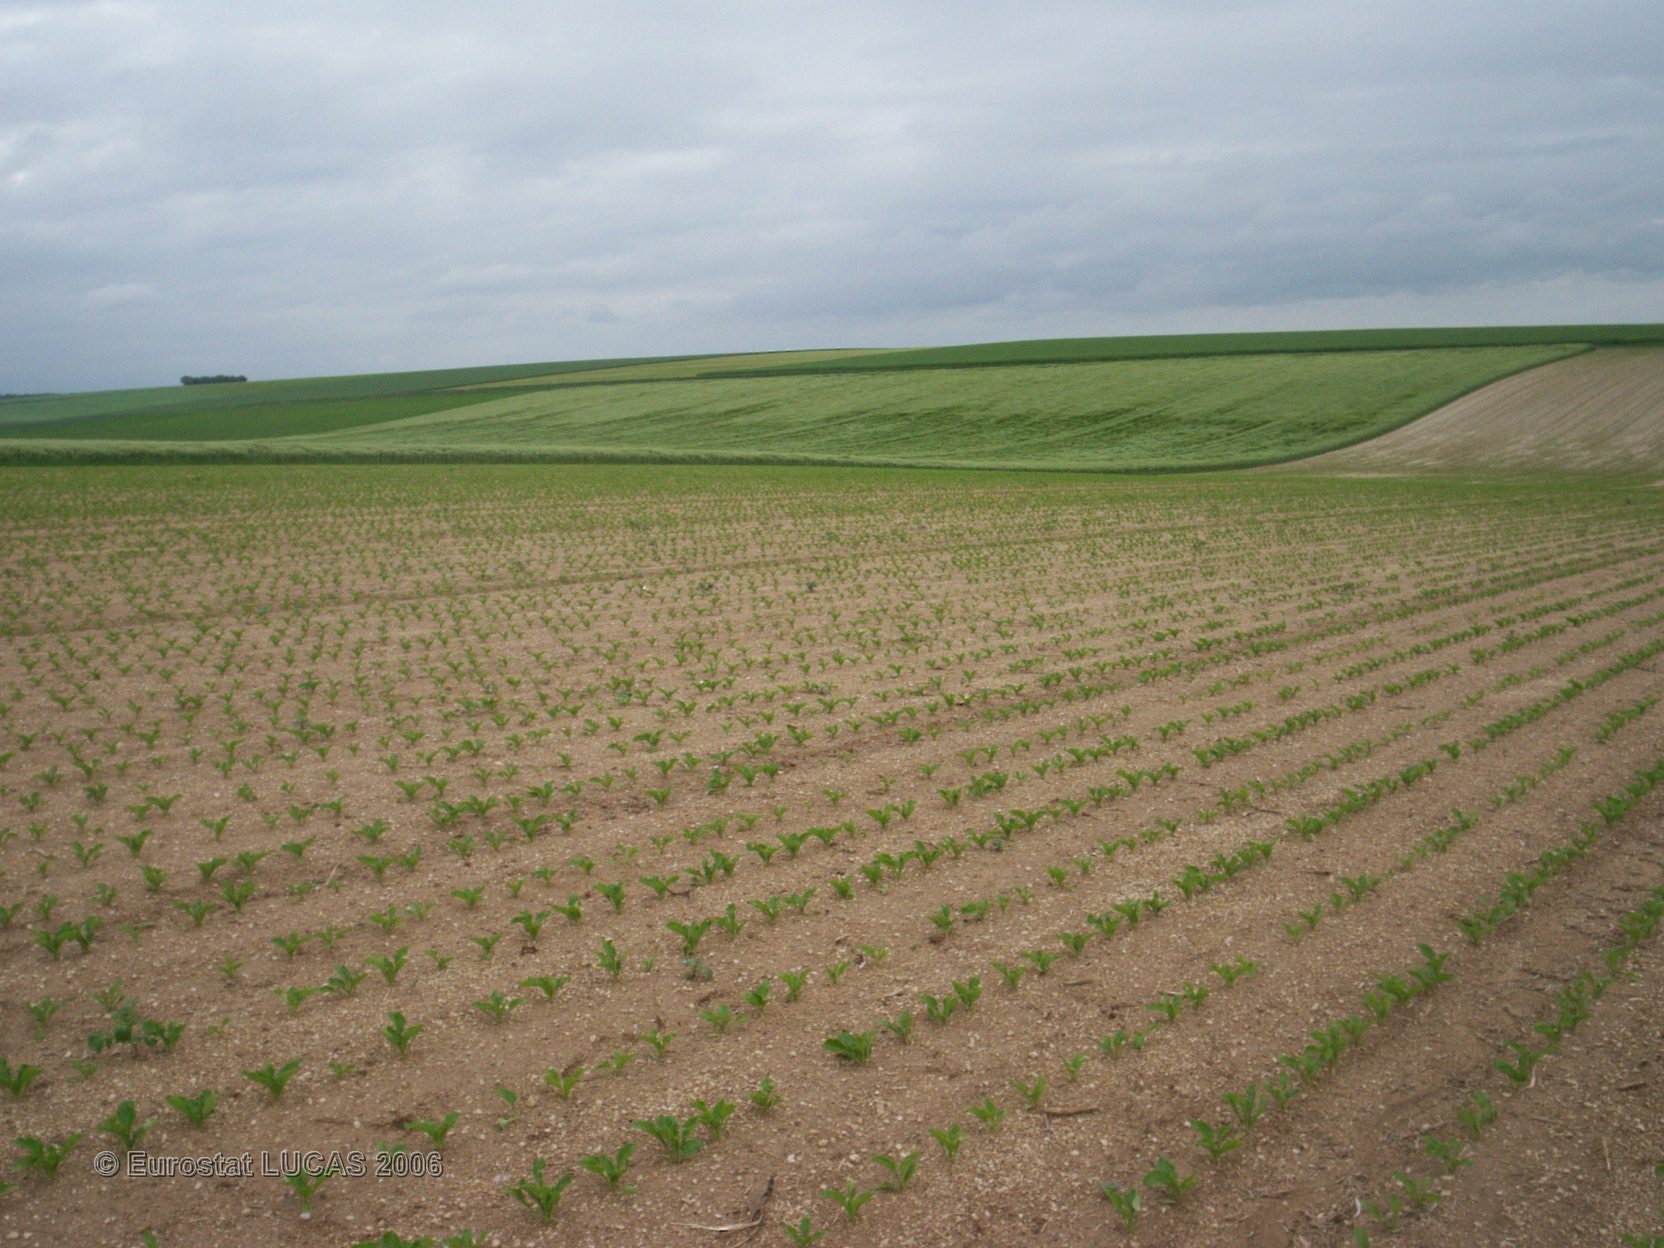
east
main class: Cropland
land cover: Sugar beet
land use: Agriculture (excluding fallow land and kitchen gardens)
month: May
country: FR
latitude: 49.4122
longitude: 4.3309
